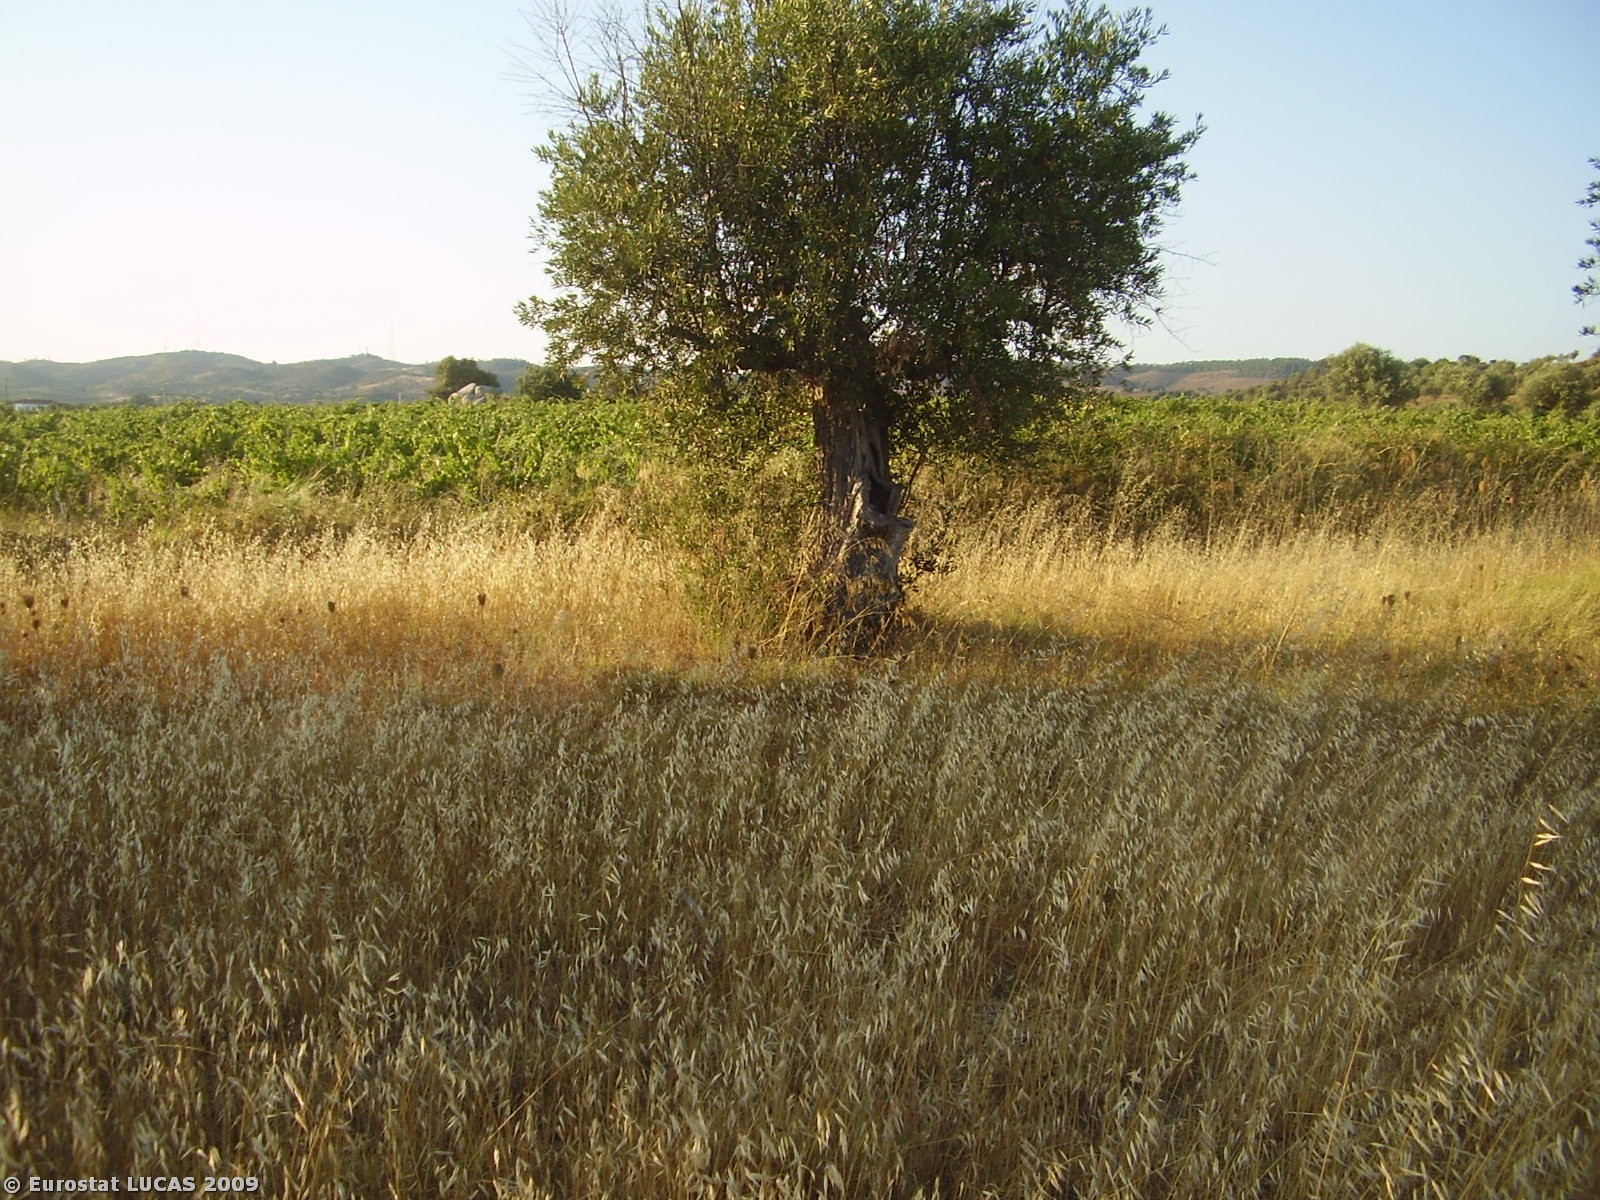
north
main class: Cropland
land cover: Olive groves
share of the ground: 10 - 25 %
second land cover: Spontaneously vegetated surfaces
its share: > 75 %
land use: Agriculture (excluding fallow land and kitchen gardens)
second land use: Fallow land
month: August
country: PT
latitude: 38.2063
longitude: -7.7645
